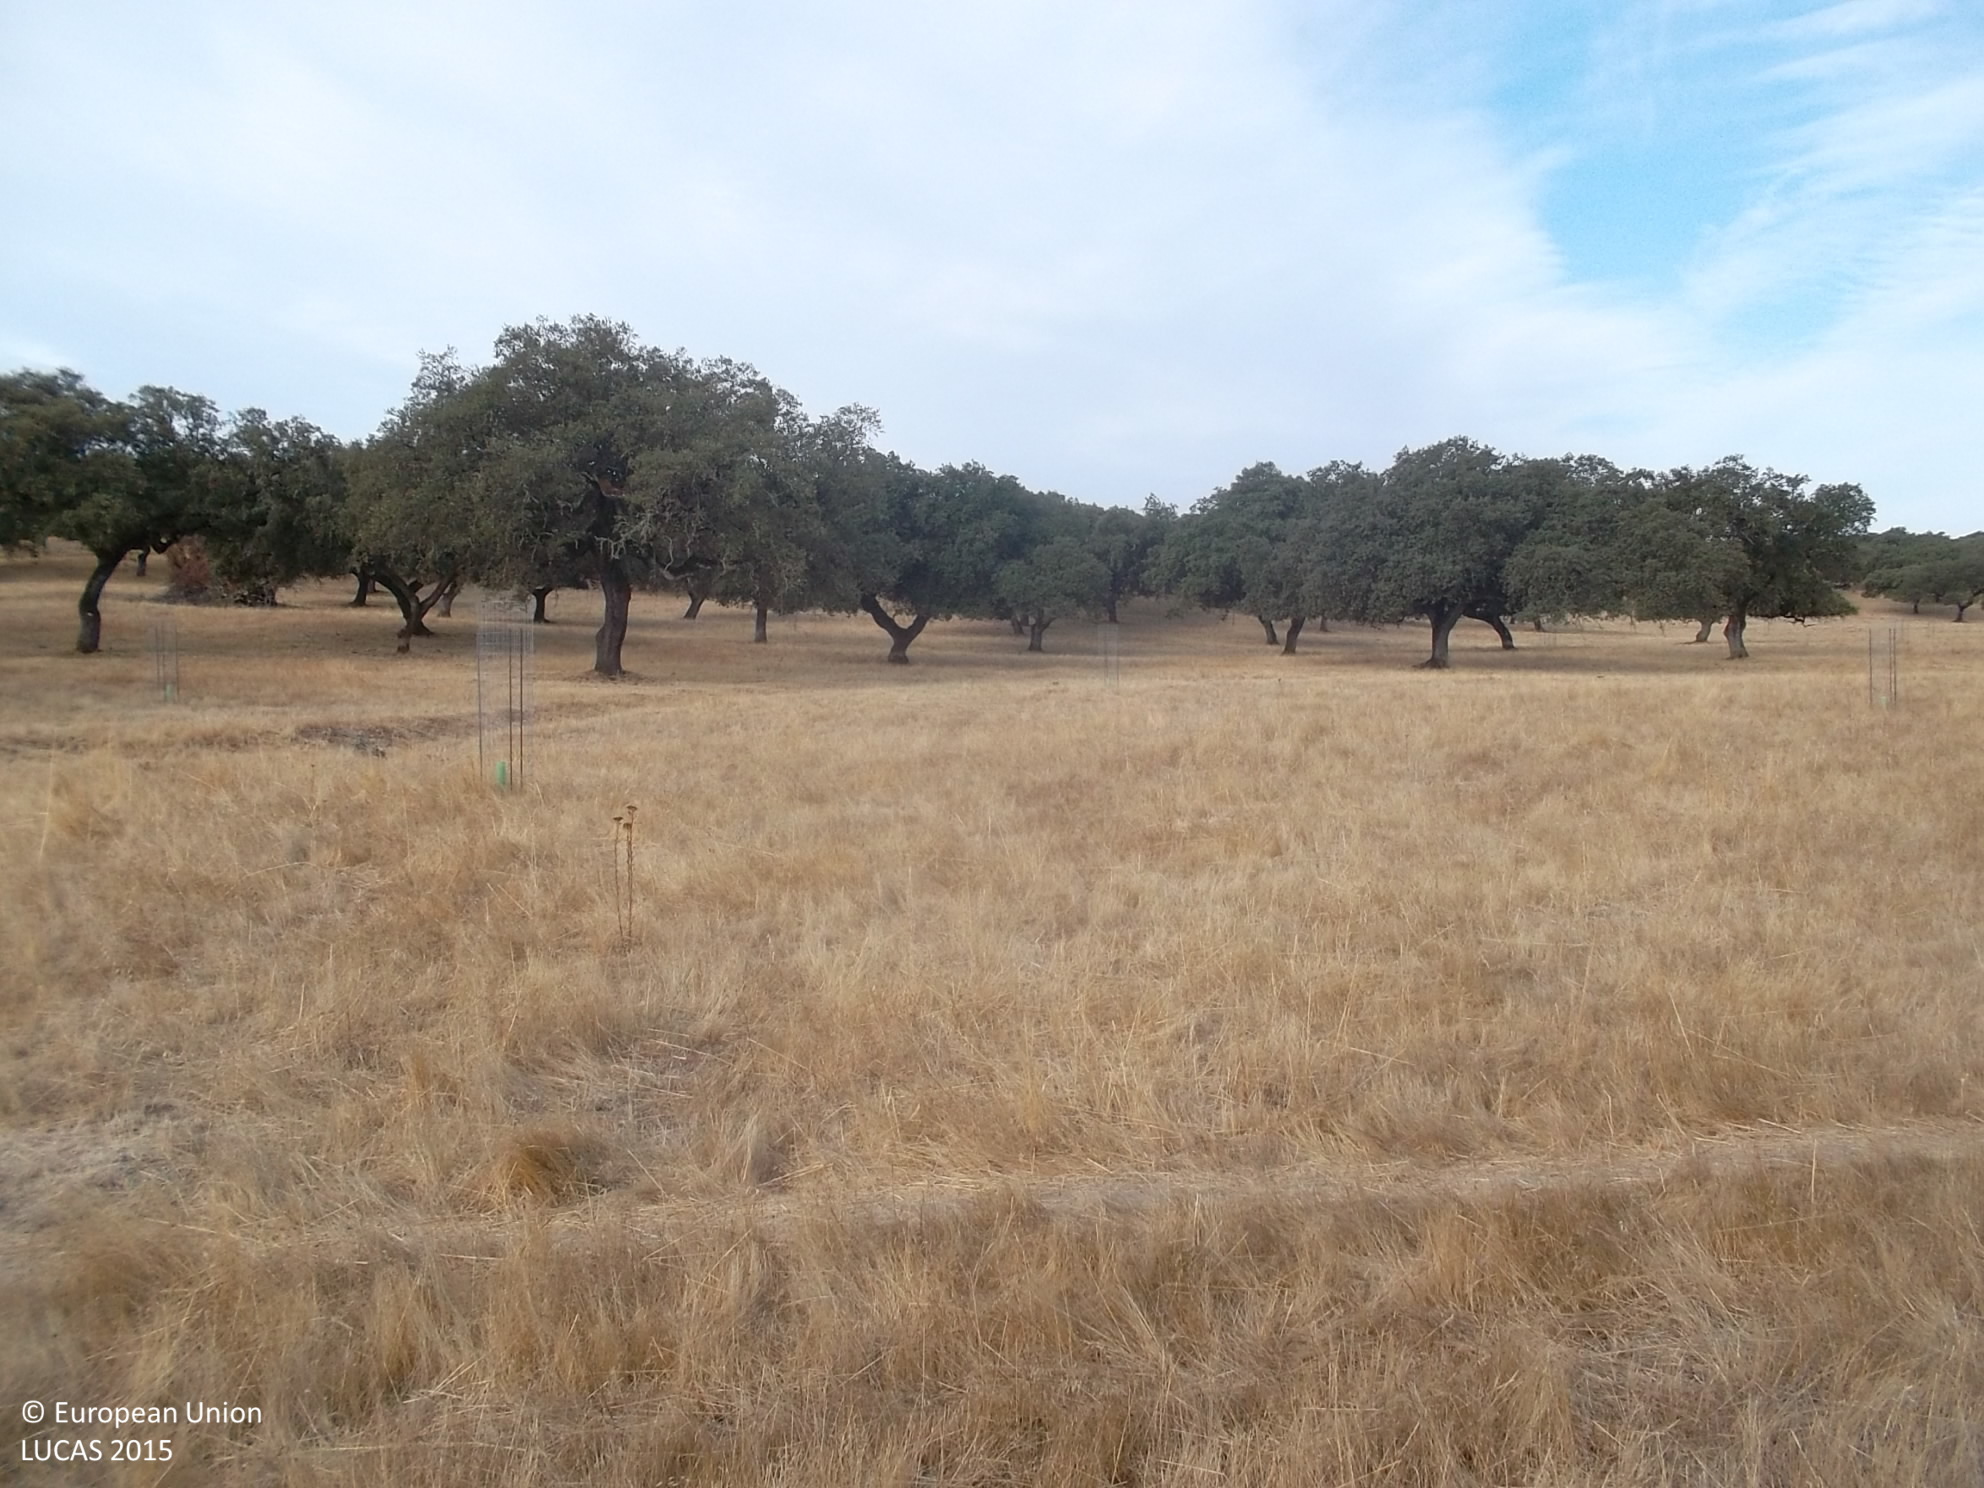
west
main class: Grassland
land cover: Grassland without tree/shrub cover
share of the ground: > 75 %
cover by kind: herbaceous plants 100 %
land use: Agriculture (excluding fallow land and kitchen gardens)
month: September
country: ES
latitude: 38.4251
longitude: -6.7694
